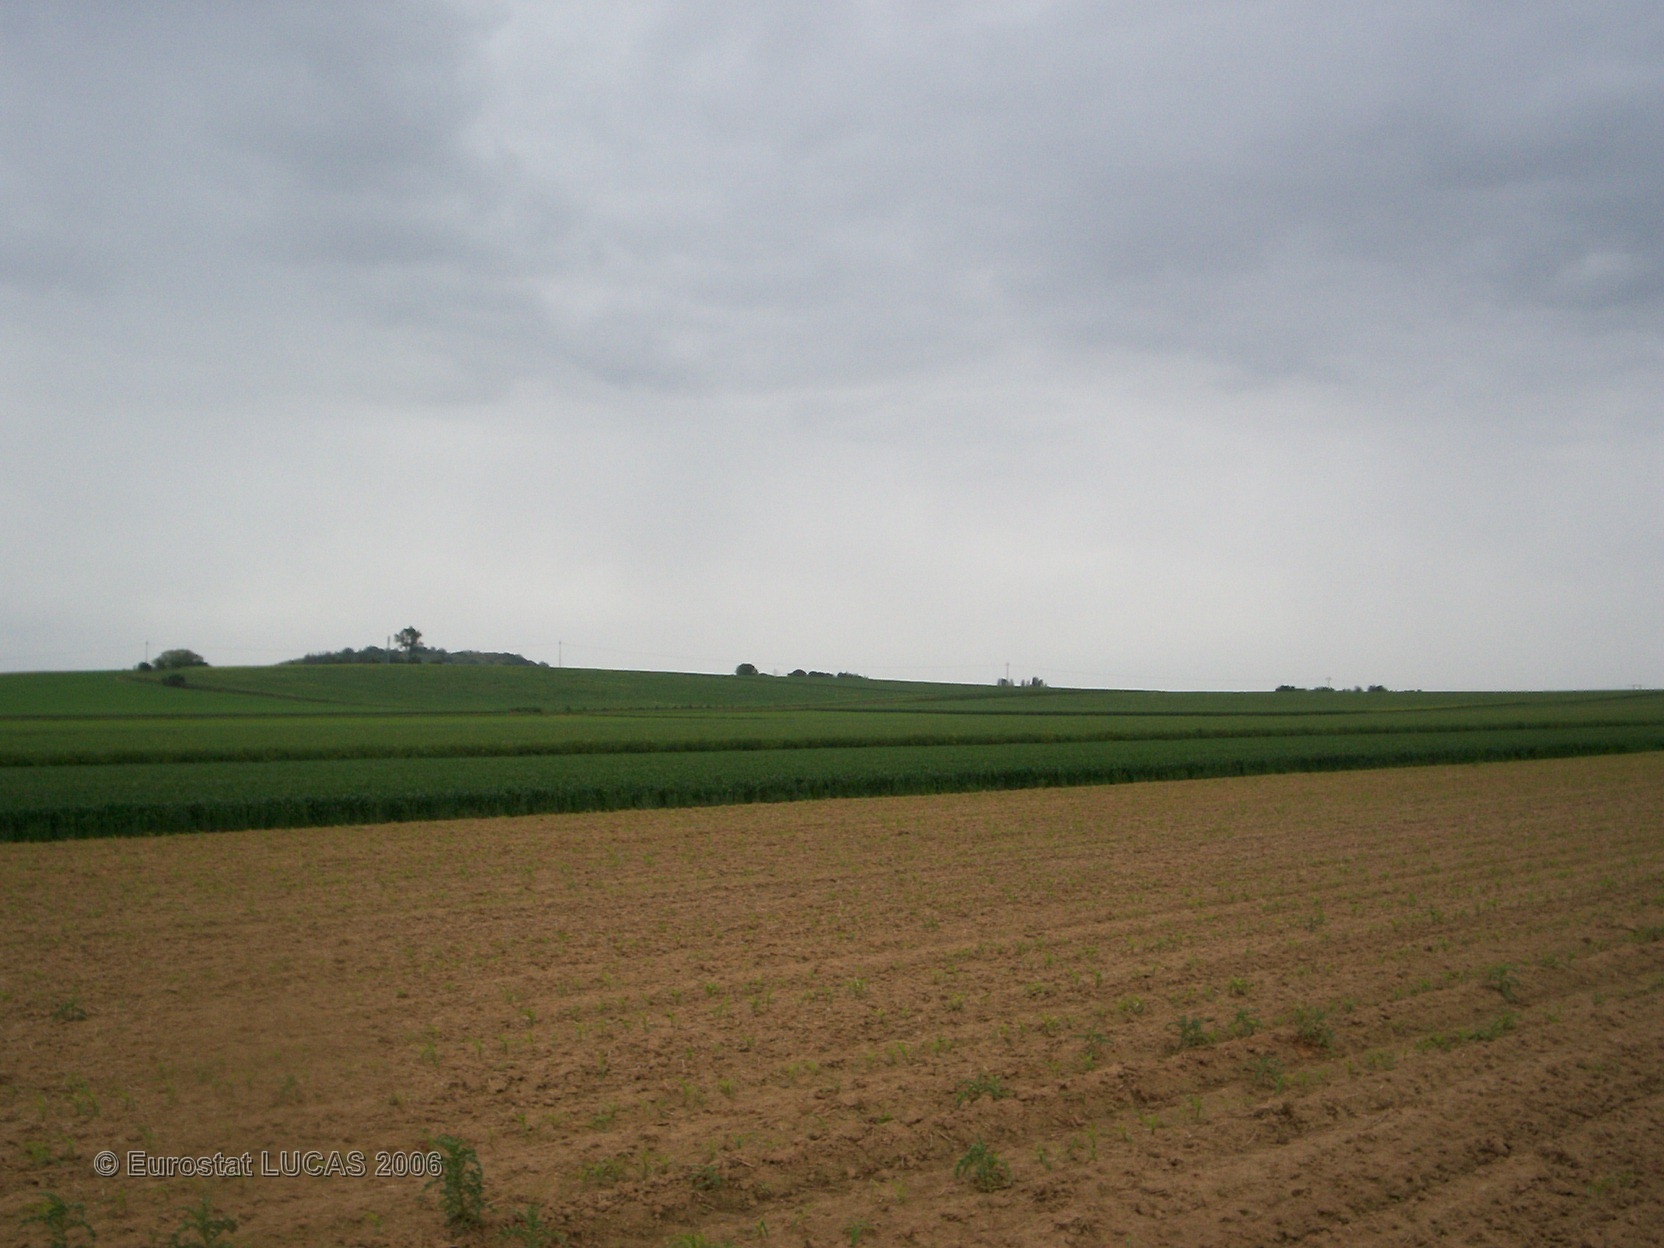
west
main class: Cropland
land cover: Maize
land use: Agriculture (excluding fallow land and kitchen gardens)
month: June
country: FR
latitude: 49.3707
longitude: 2.6763
